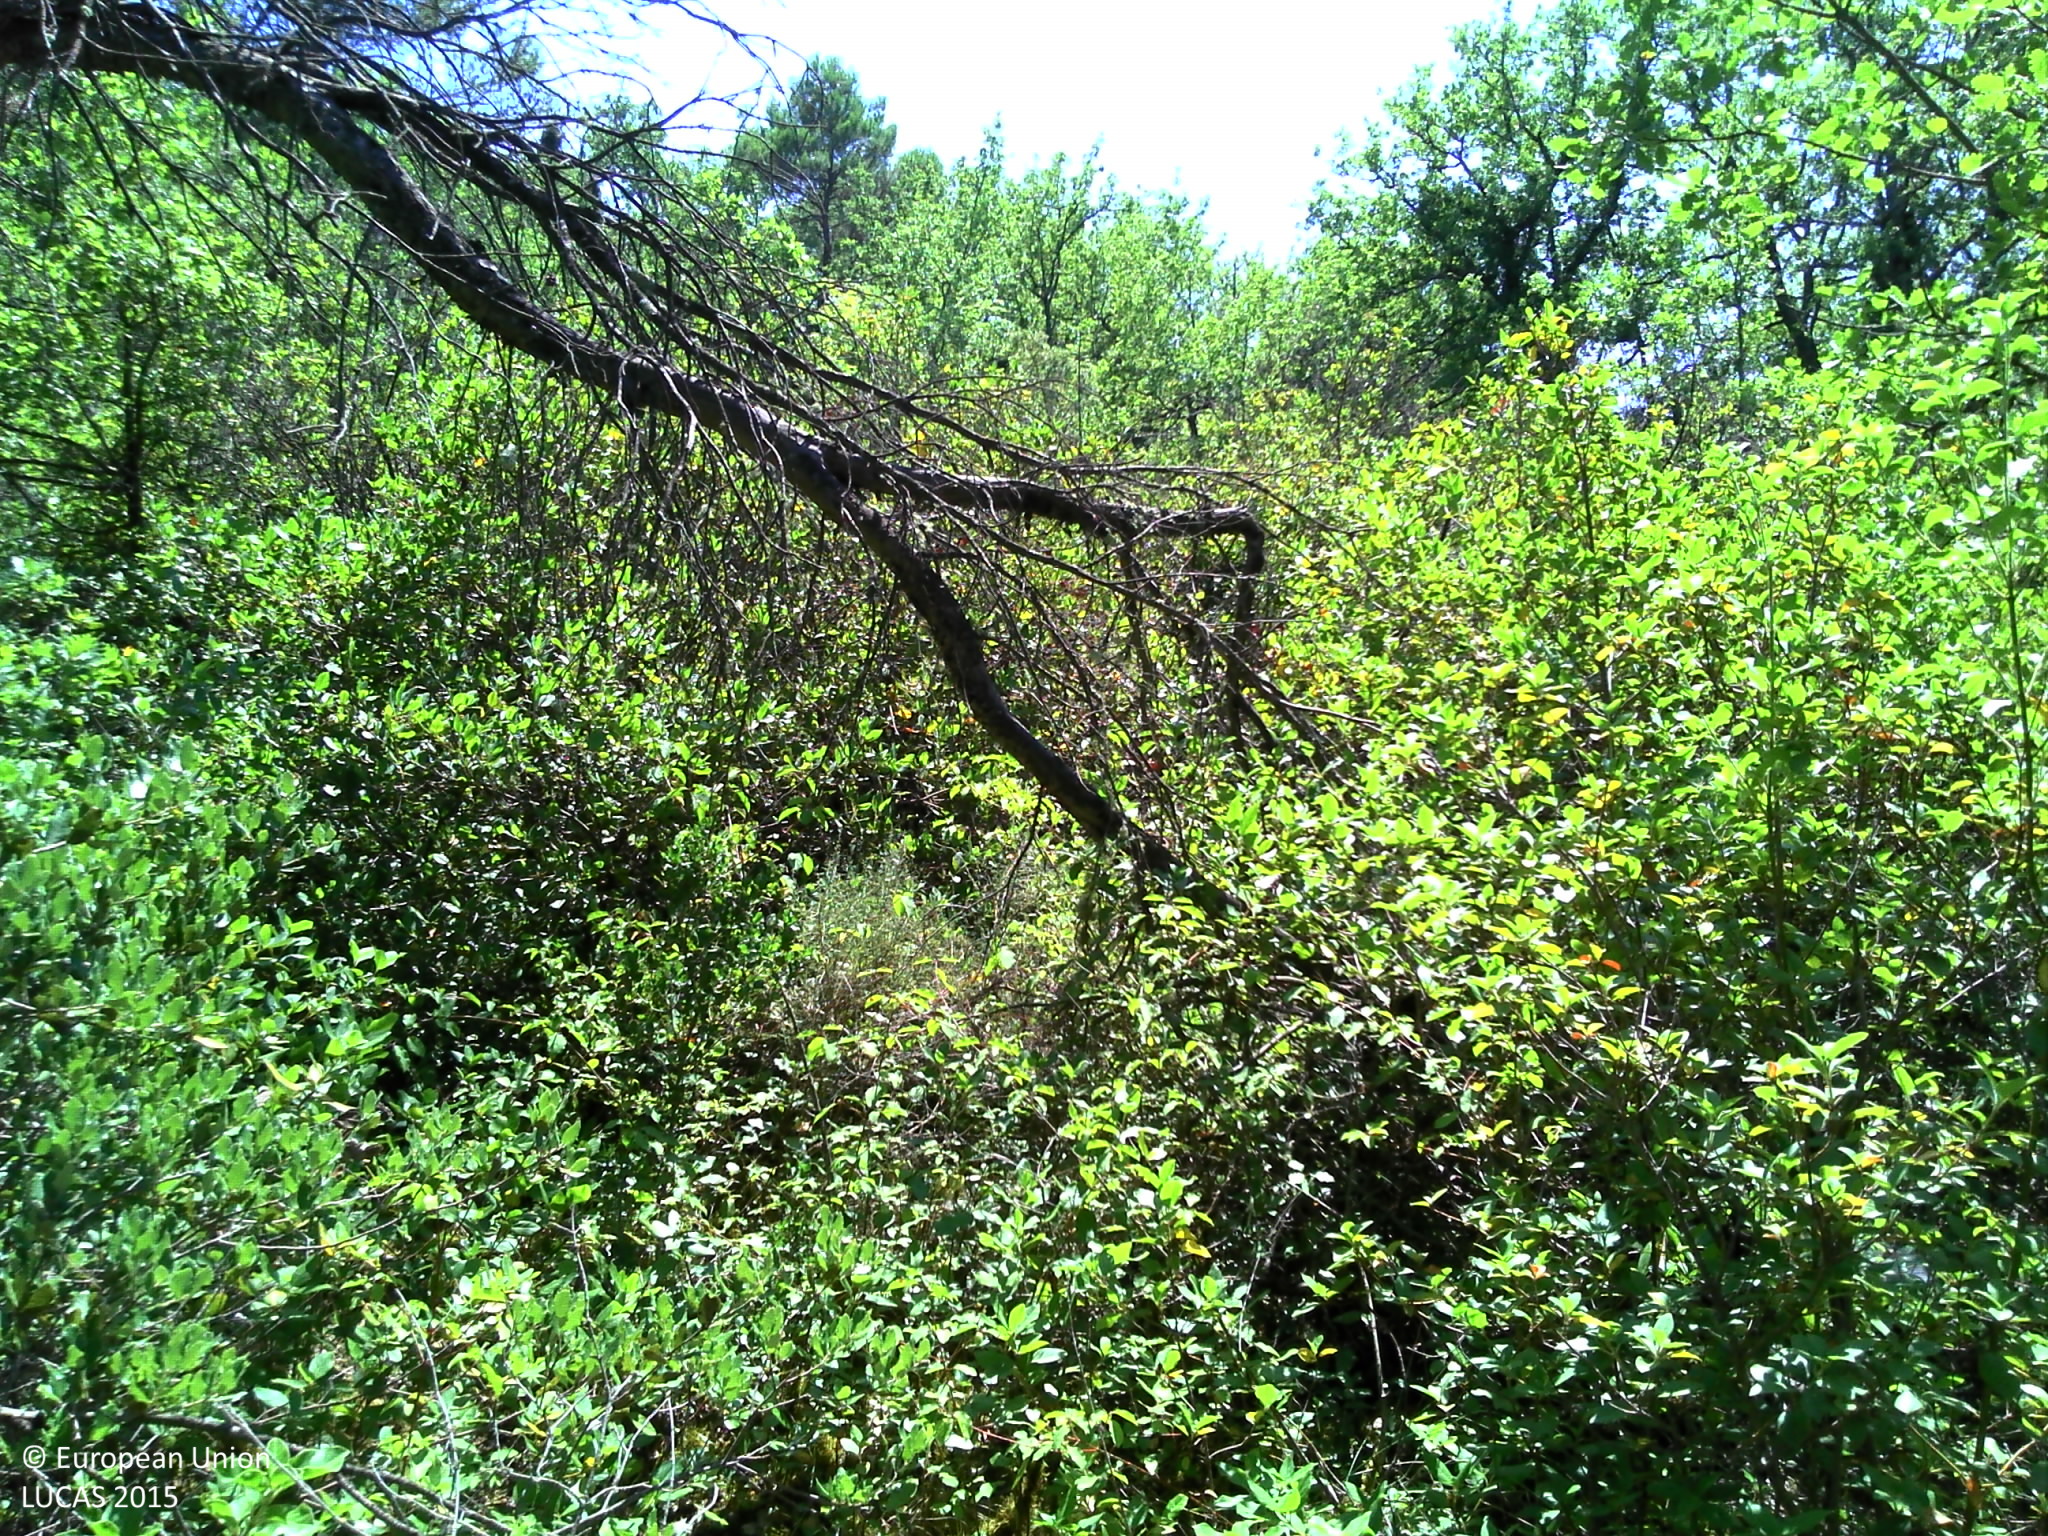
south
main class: Woodland
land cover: Pine dominated mixed woodland
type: coniferous forest of the mediterranean region
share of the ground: 50 - 75 %
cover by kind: coniferous forest trees 40 %, broadleaved forest trees 30 %, shrubs 20 %, herbaceous plants 5 %, lichens and mosses 5 %
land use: Forestry
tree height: > 5 m
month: July
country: FR
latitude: 44.0218
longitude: 5.1804
